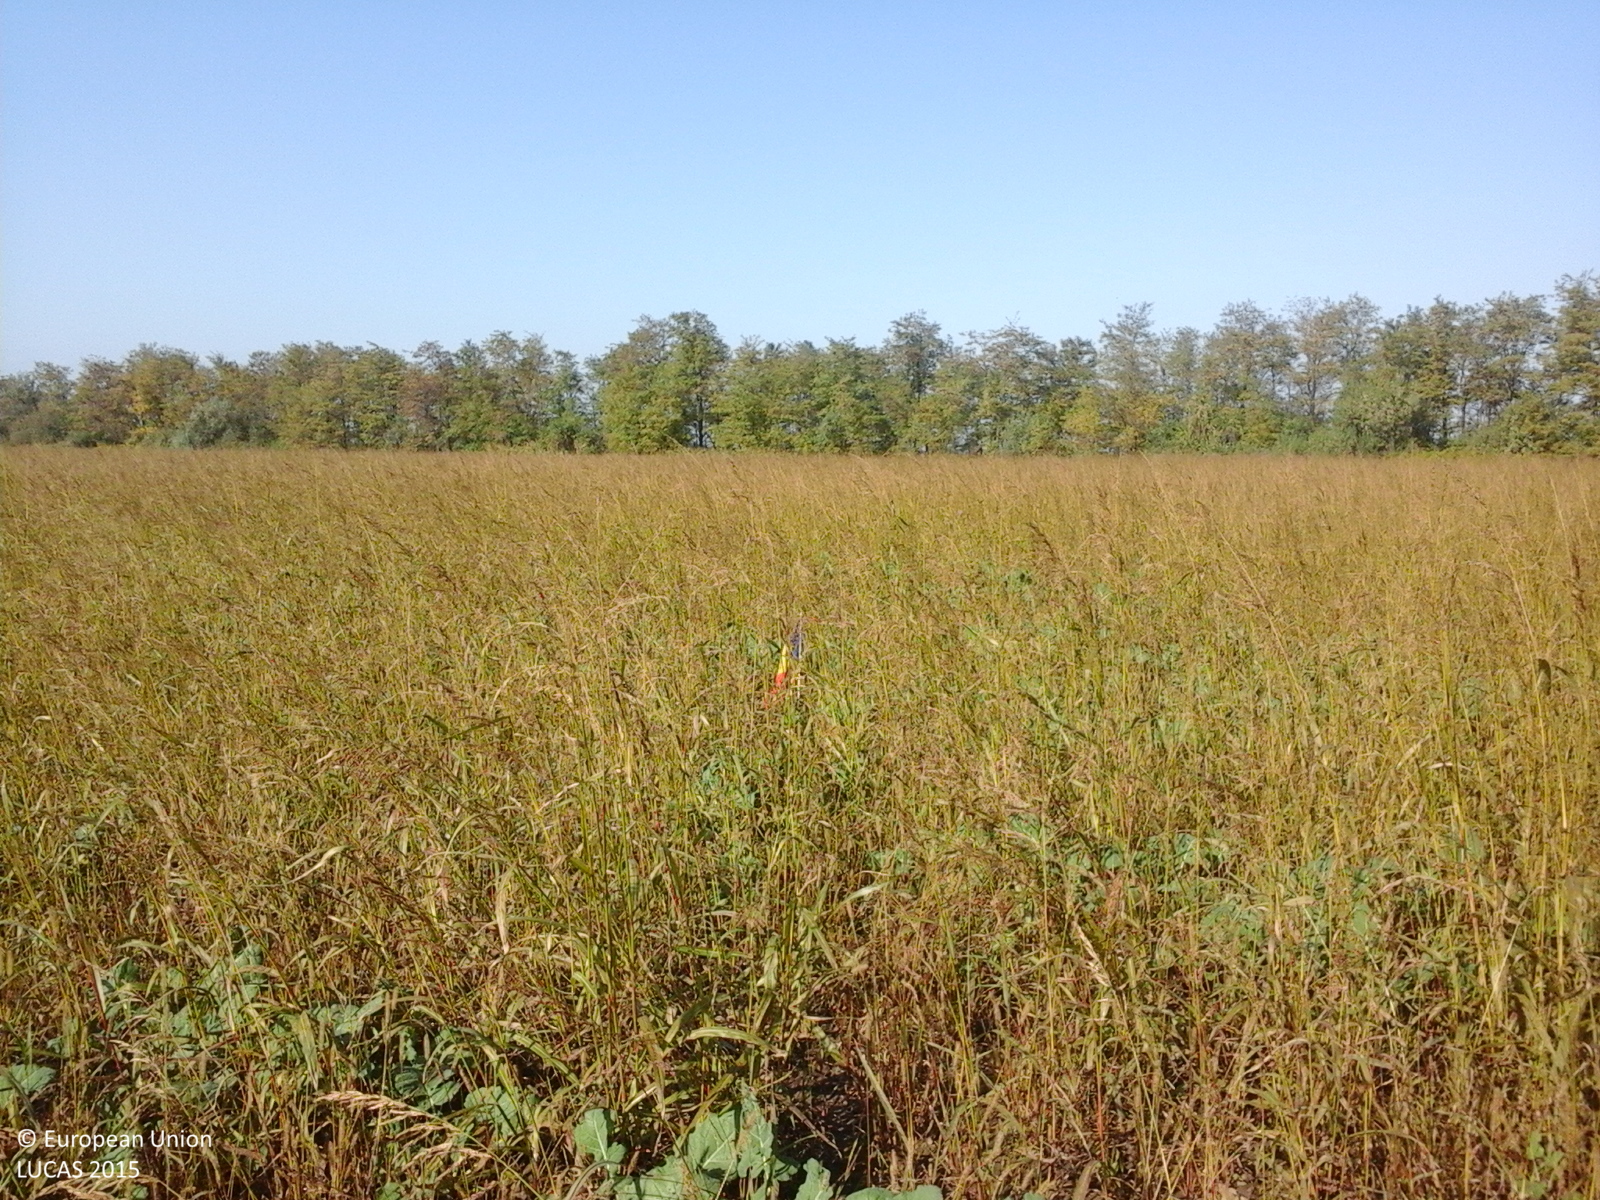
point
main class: Grassland
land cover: Spontaneously vegetated surfaces
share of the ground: > 75 %
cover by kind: herbaceous plants 100 %
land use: Fallow land
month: October
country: RO
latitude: 45.4494
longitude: 27.3723
